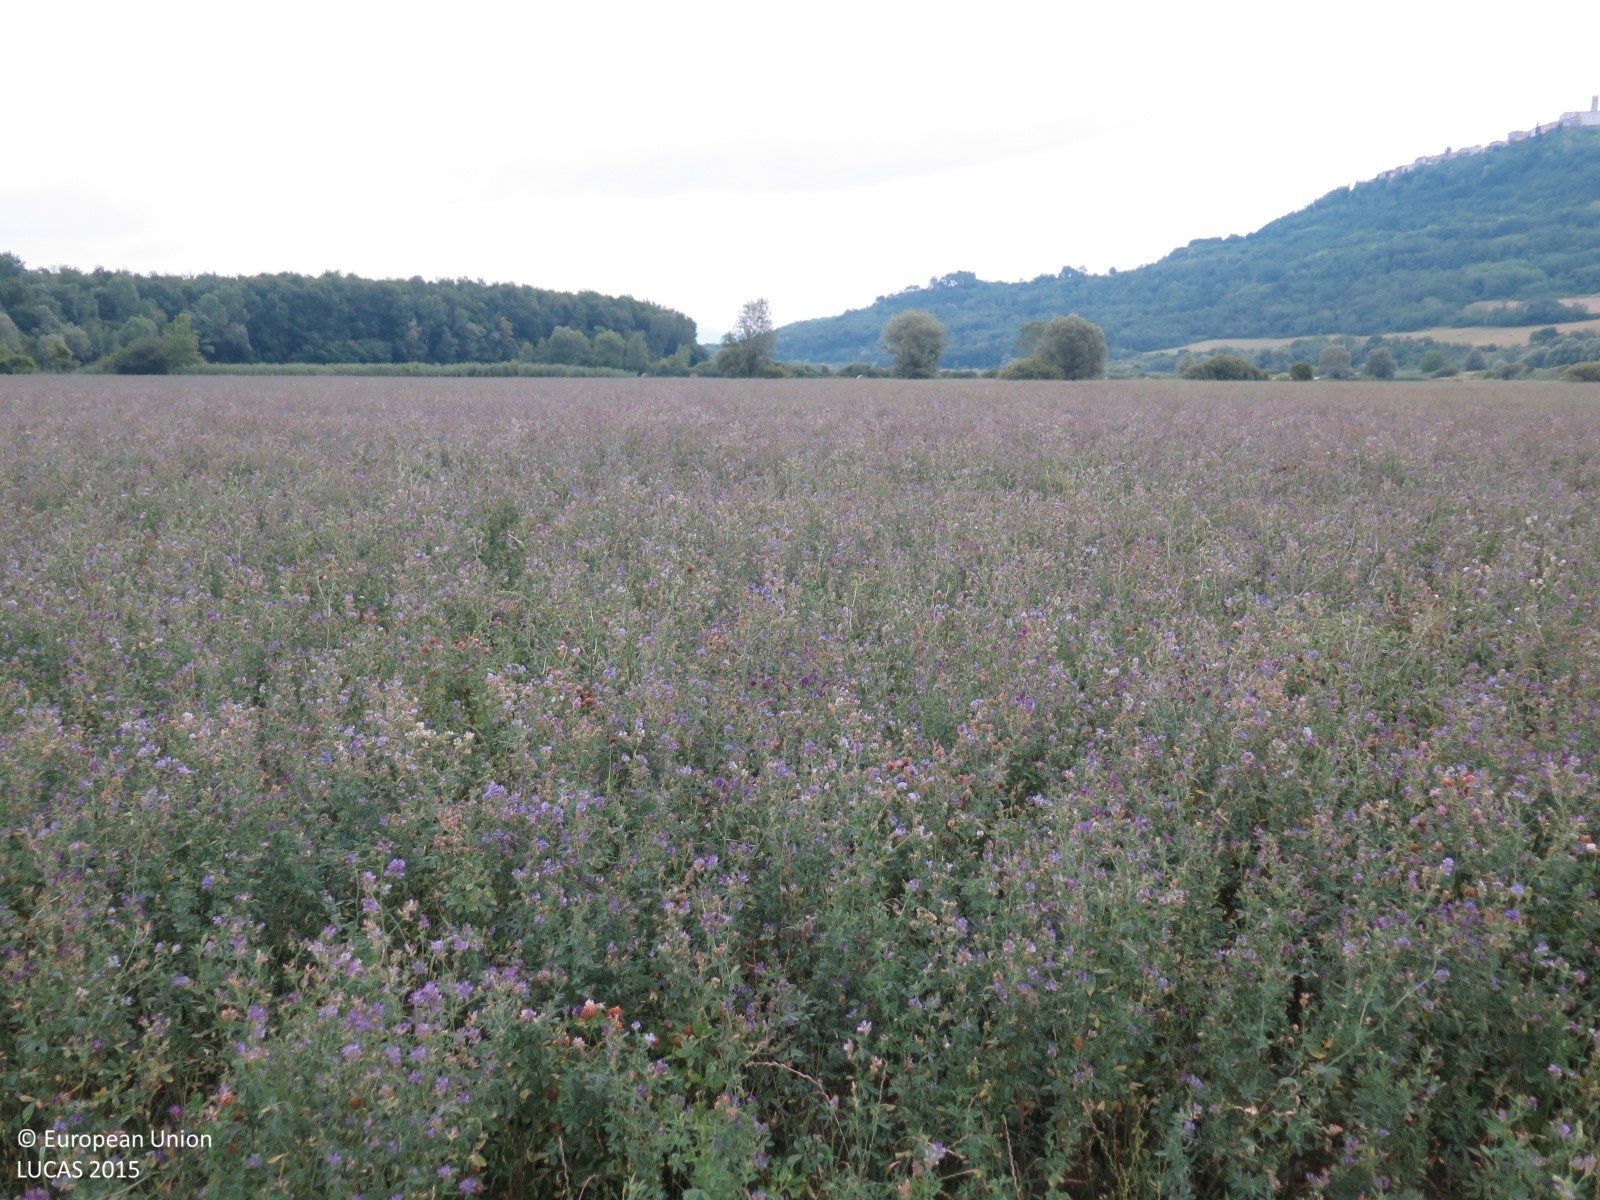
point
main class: Cropland
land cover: Lucerne
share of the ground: > 75 %
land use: Agriculture (excluding fallow land and kitchen gardens)
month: July
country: HR
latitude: 45.3454
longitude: 13.8111
